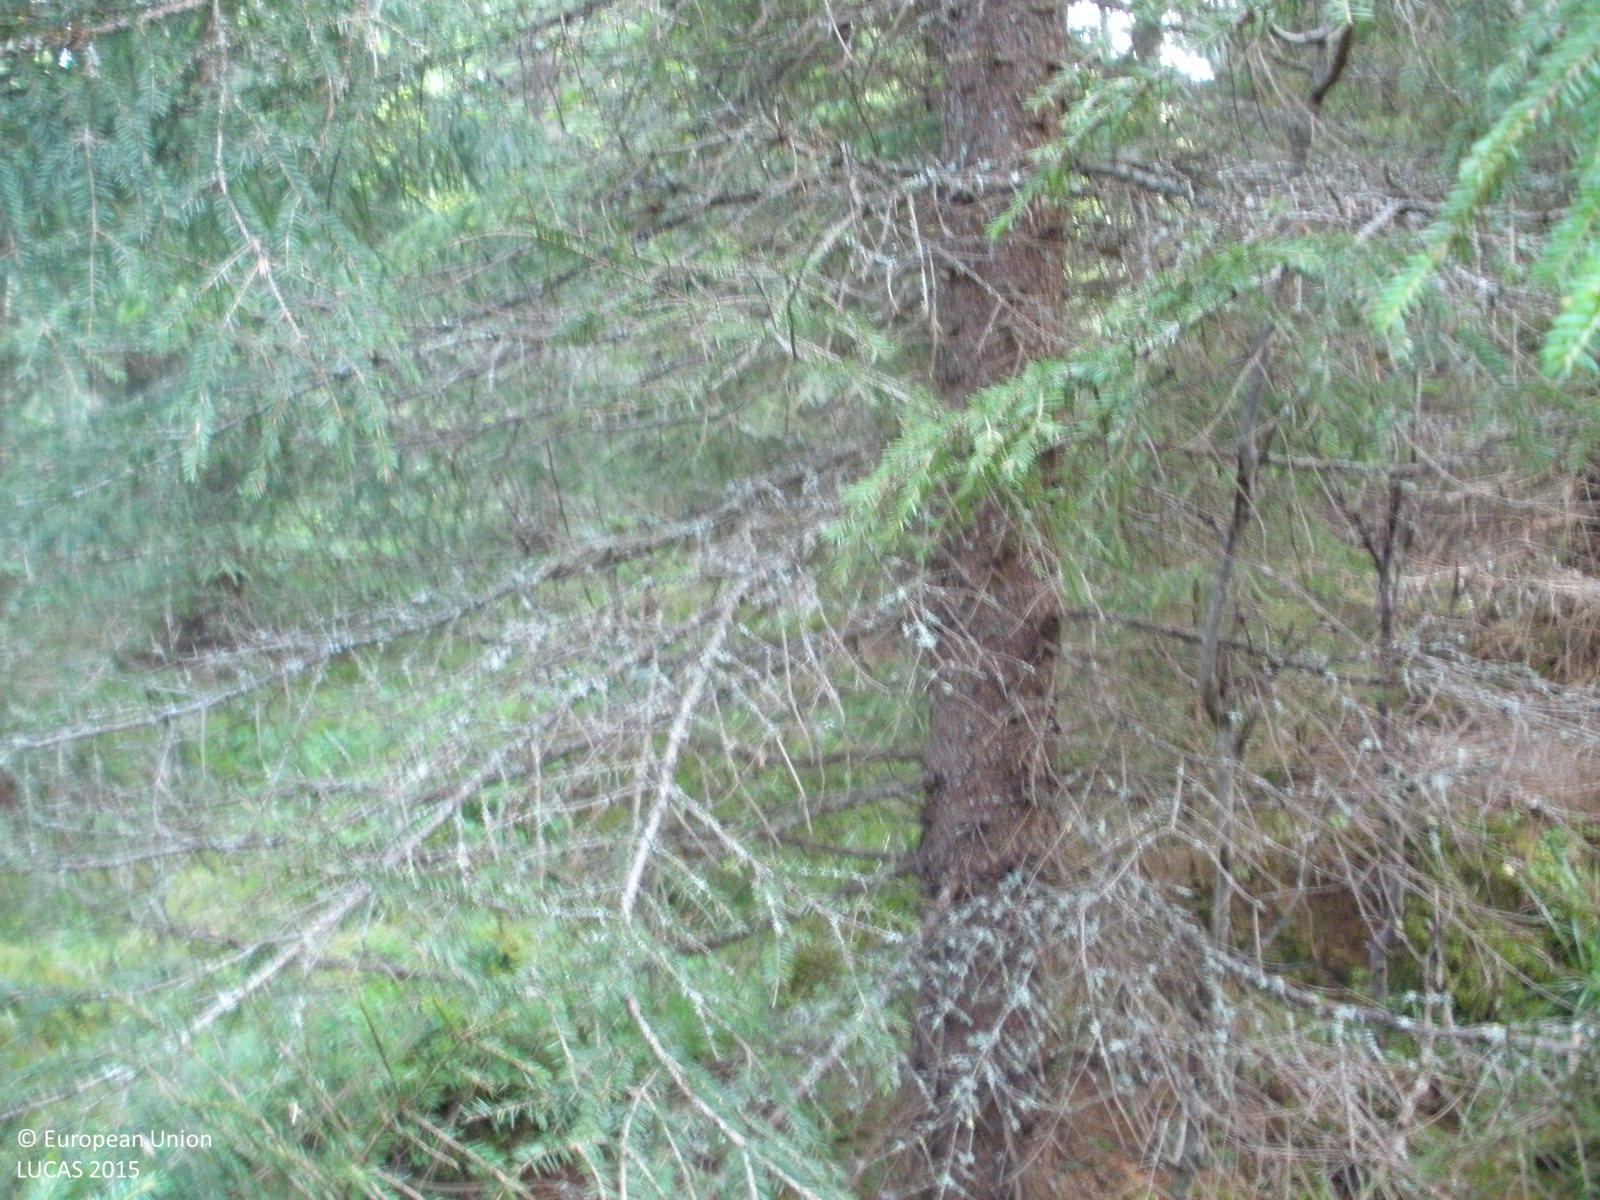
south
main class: Woodland
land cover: Spruce dominated coniferous woodland
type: boreal forest
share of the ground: > 75 %
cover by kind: coniferous forest trees 80 %, lichens and mosses 10 %, broadleaved forest trees 5 %, herbaceous plants 5 %
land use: Forestry
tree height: > 5 m
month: August
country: FI
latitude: 61.0090
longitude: 24.8137
